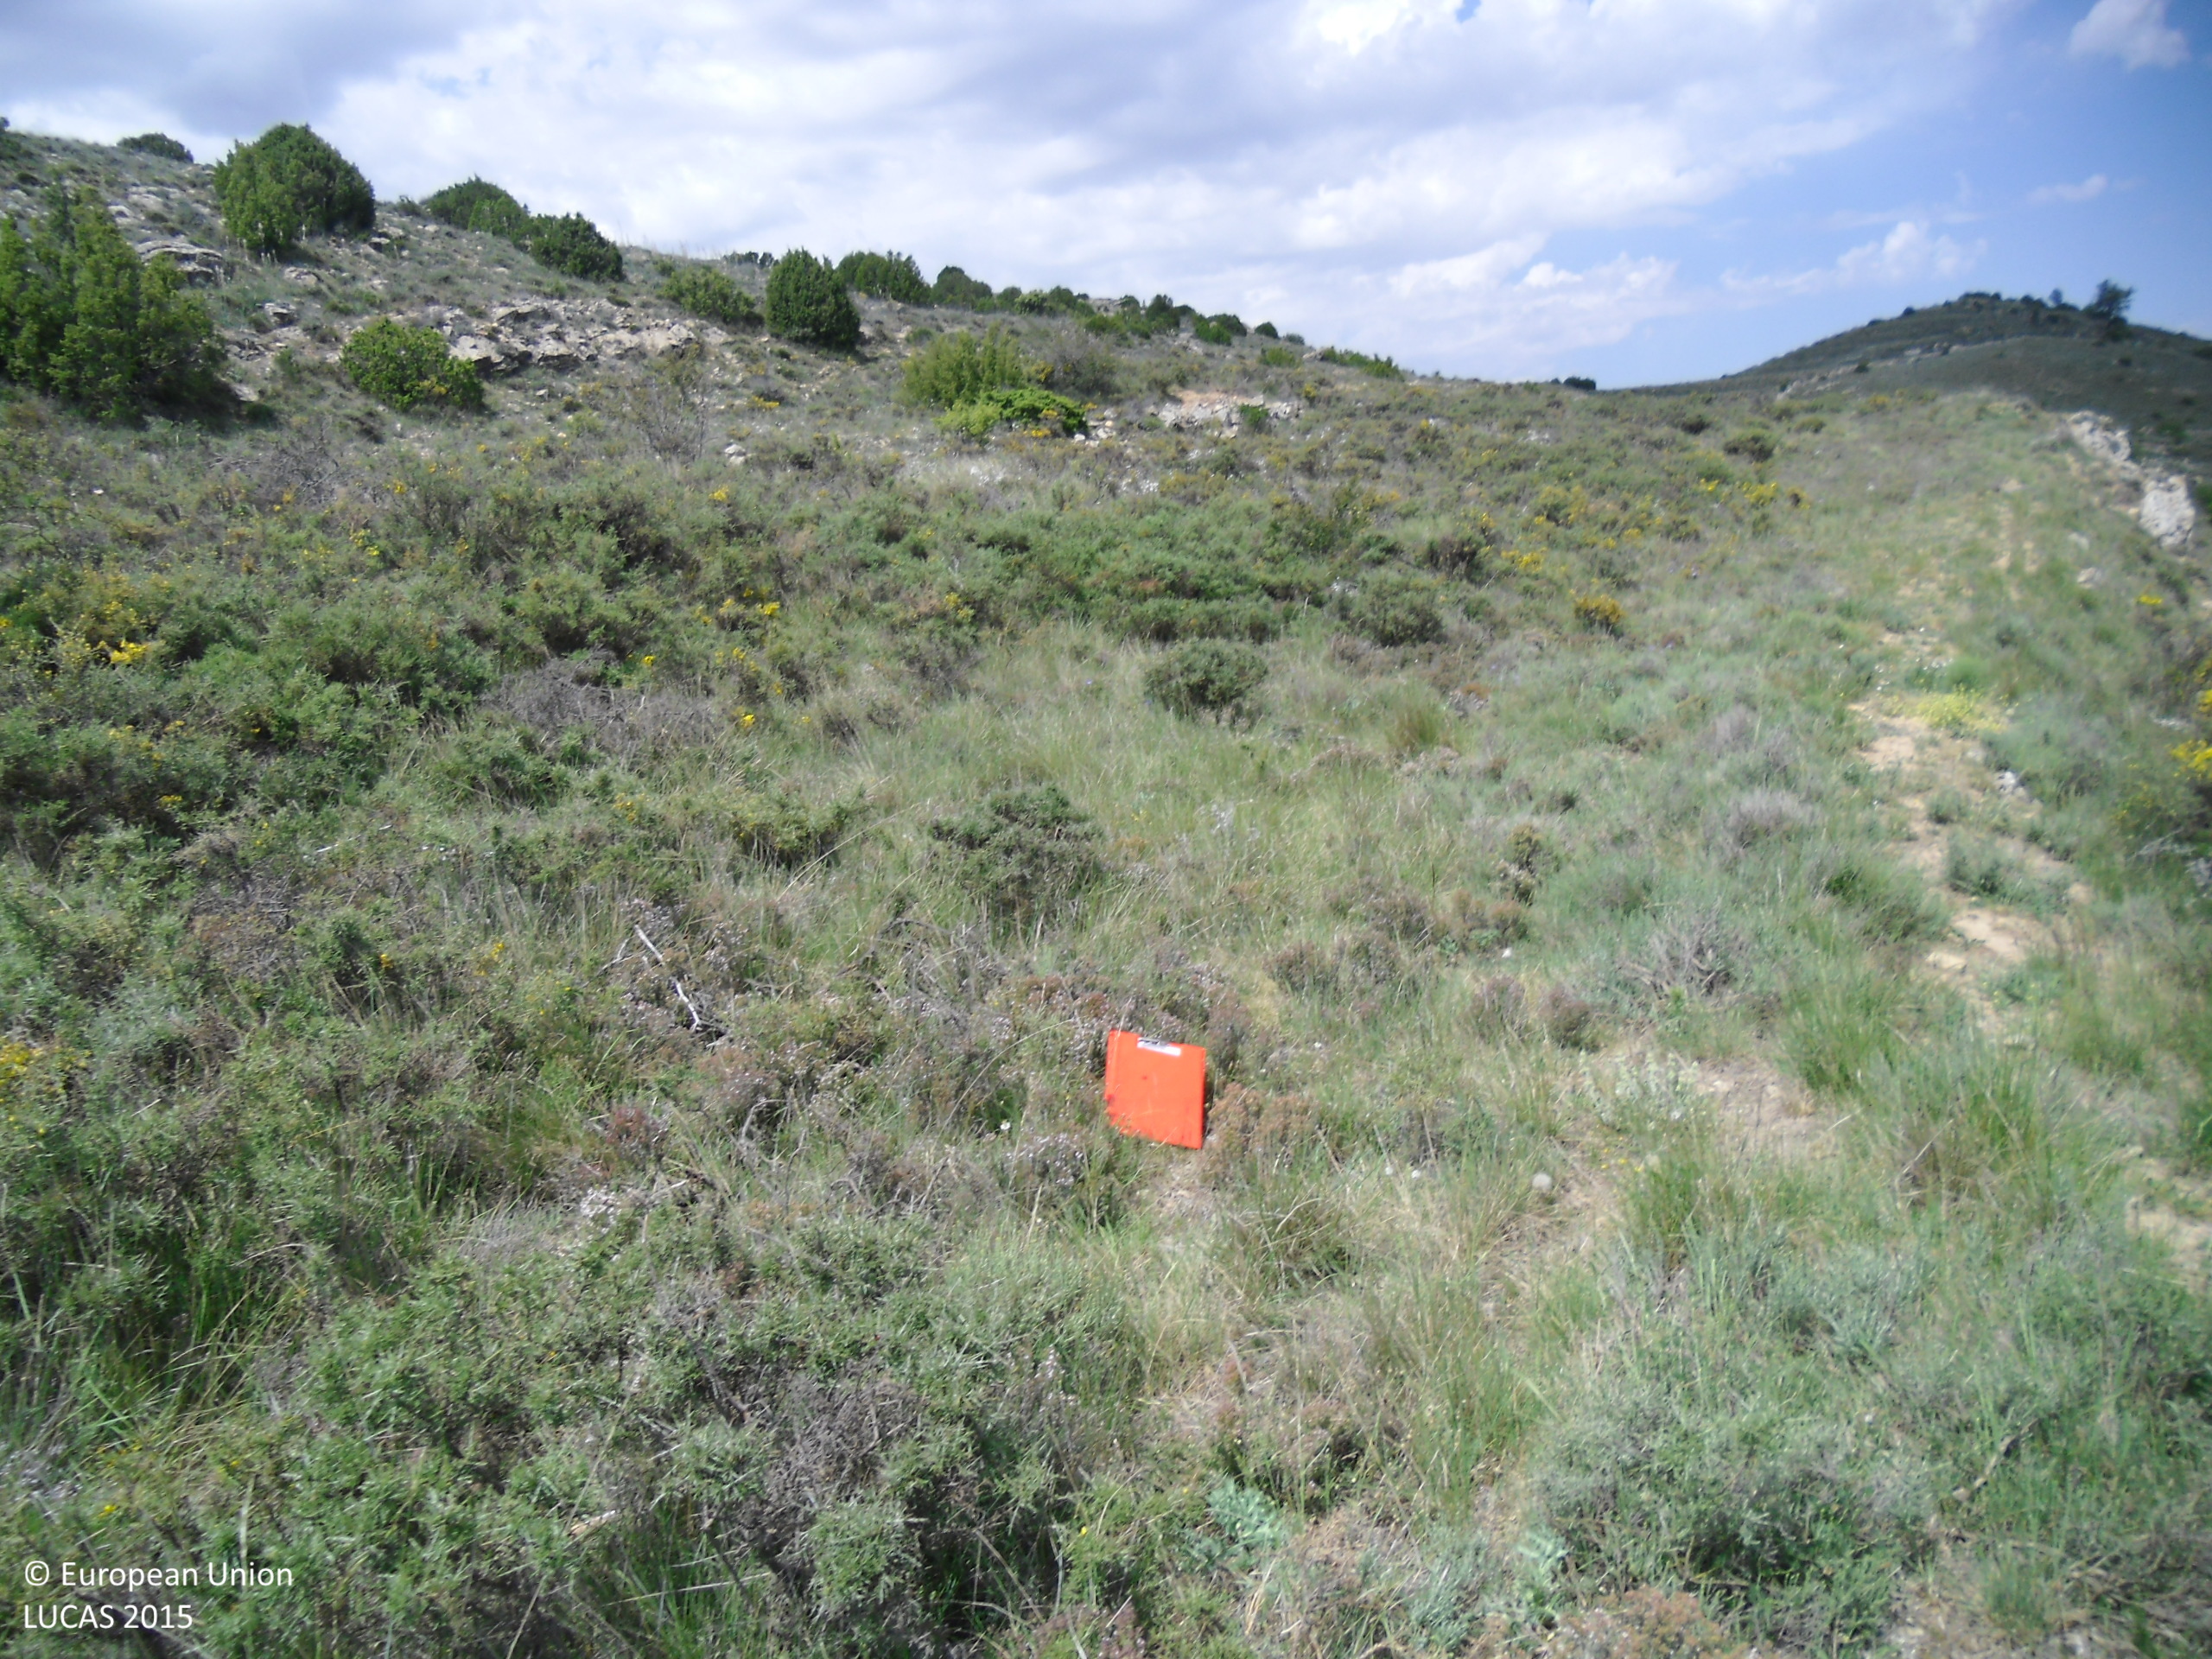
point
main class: Shrubland
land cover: Shrubland without tree cover
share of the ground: > 75 %
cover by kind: shrubs 80 %, herbaceous plants 20 %
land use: Agriculture (excluding fallow land and kitchen gardens)
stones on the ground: < 10 %
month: May
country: ES
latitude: 40.8828
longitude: -0.8732
